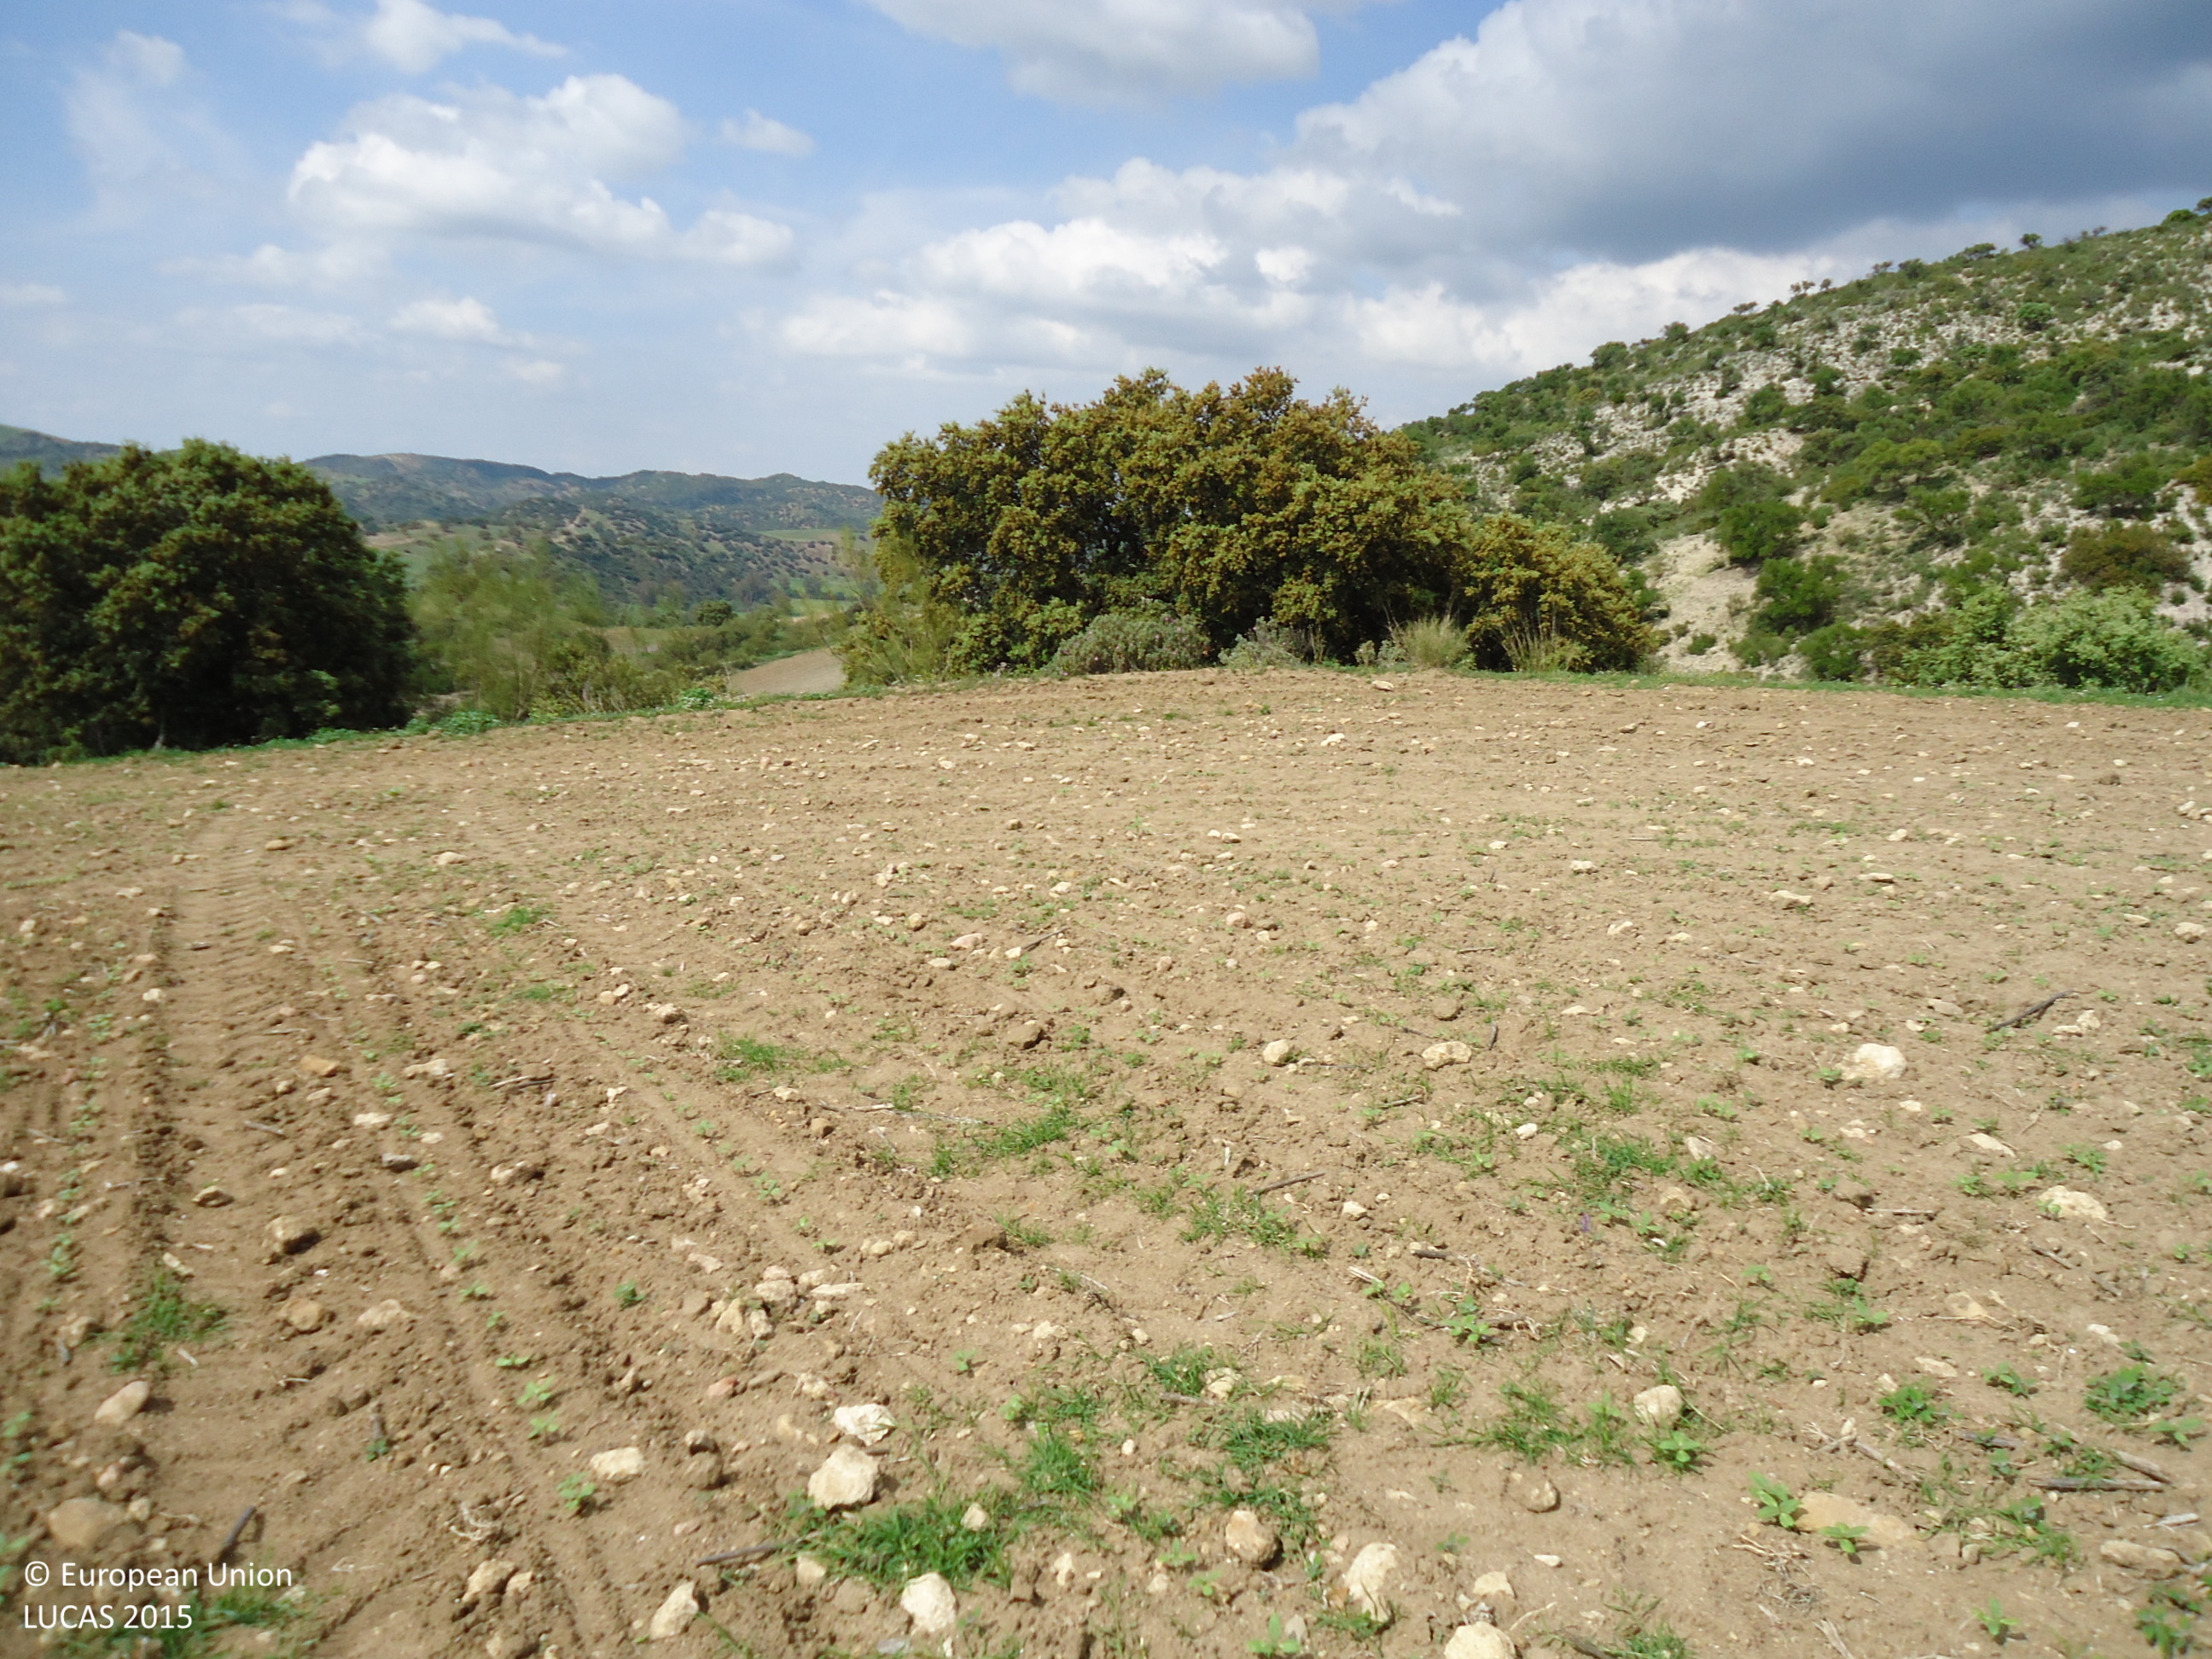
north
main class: Cropland
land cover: Sunflower
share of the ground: < 10 %
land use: Agriculture (excluding fallow land and kitchen gardens)
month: April
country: ES
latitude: 36.9811
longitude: -5.2952
